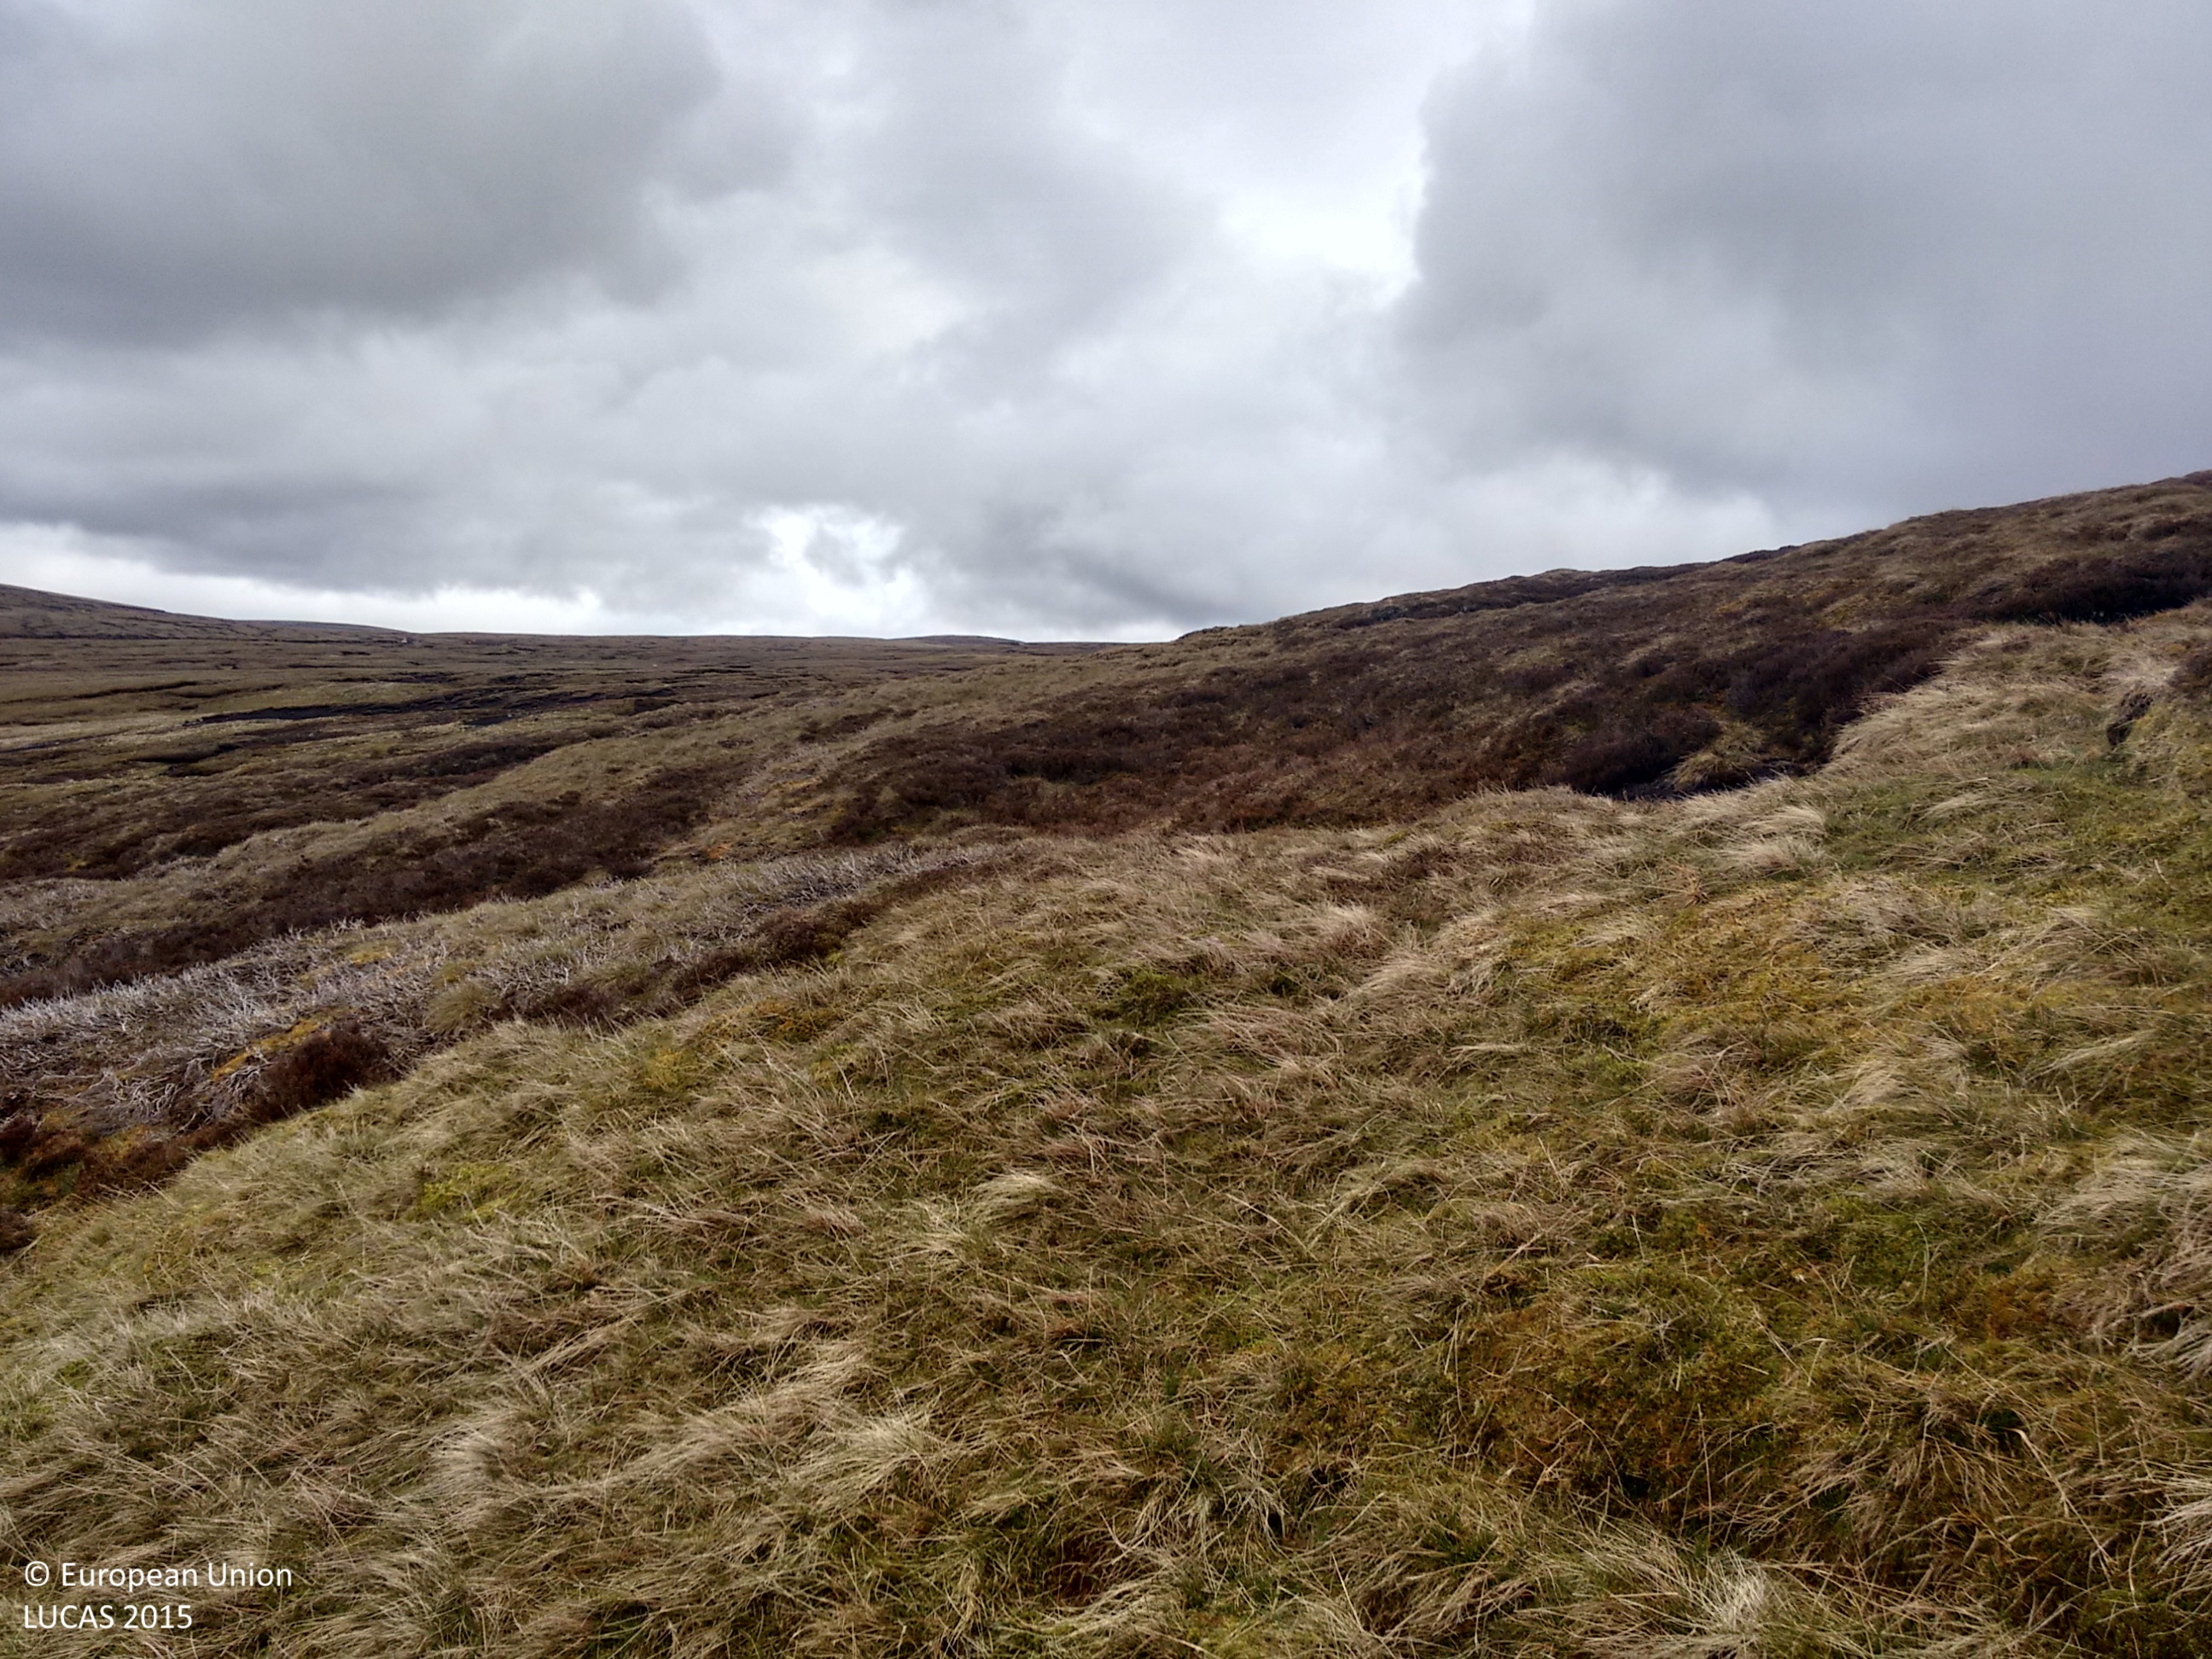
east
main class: Shrubland
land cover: Shrubland without tree cover
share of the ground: > 75 %
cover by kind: herbaceous plants 60 %, shrubs 40 %
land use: Agriculture (excluding fallow land and kitchen gardens)
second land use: Other primary production
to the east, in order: Shrubland without tree cover; Rivers and streams; Single bushes/trees; Shrubland without tree cover
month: June
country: GB
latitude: 57.2487
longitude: -4.2912
